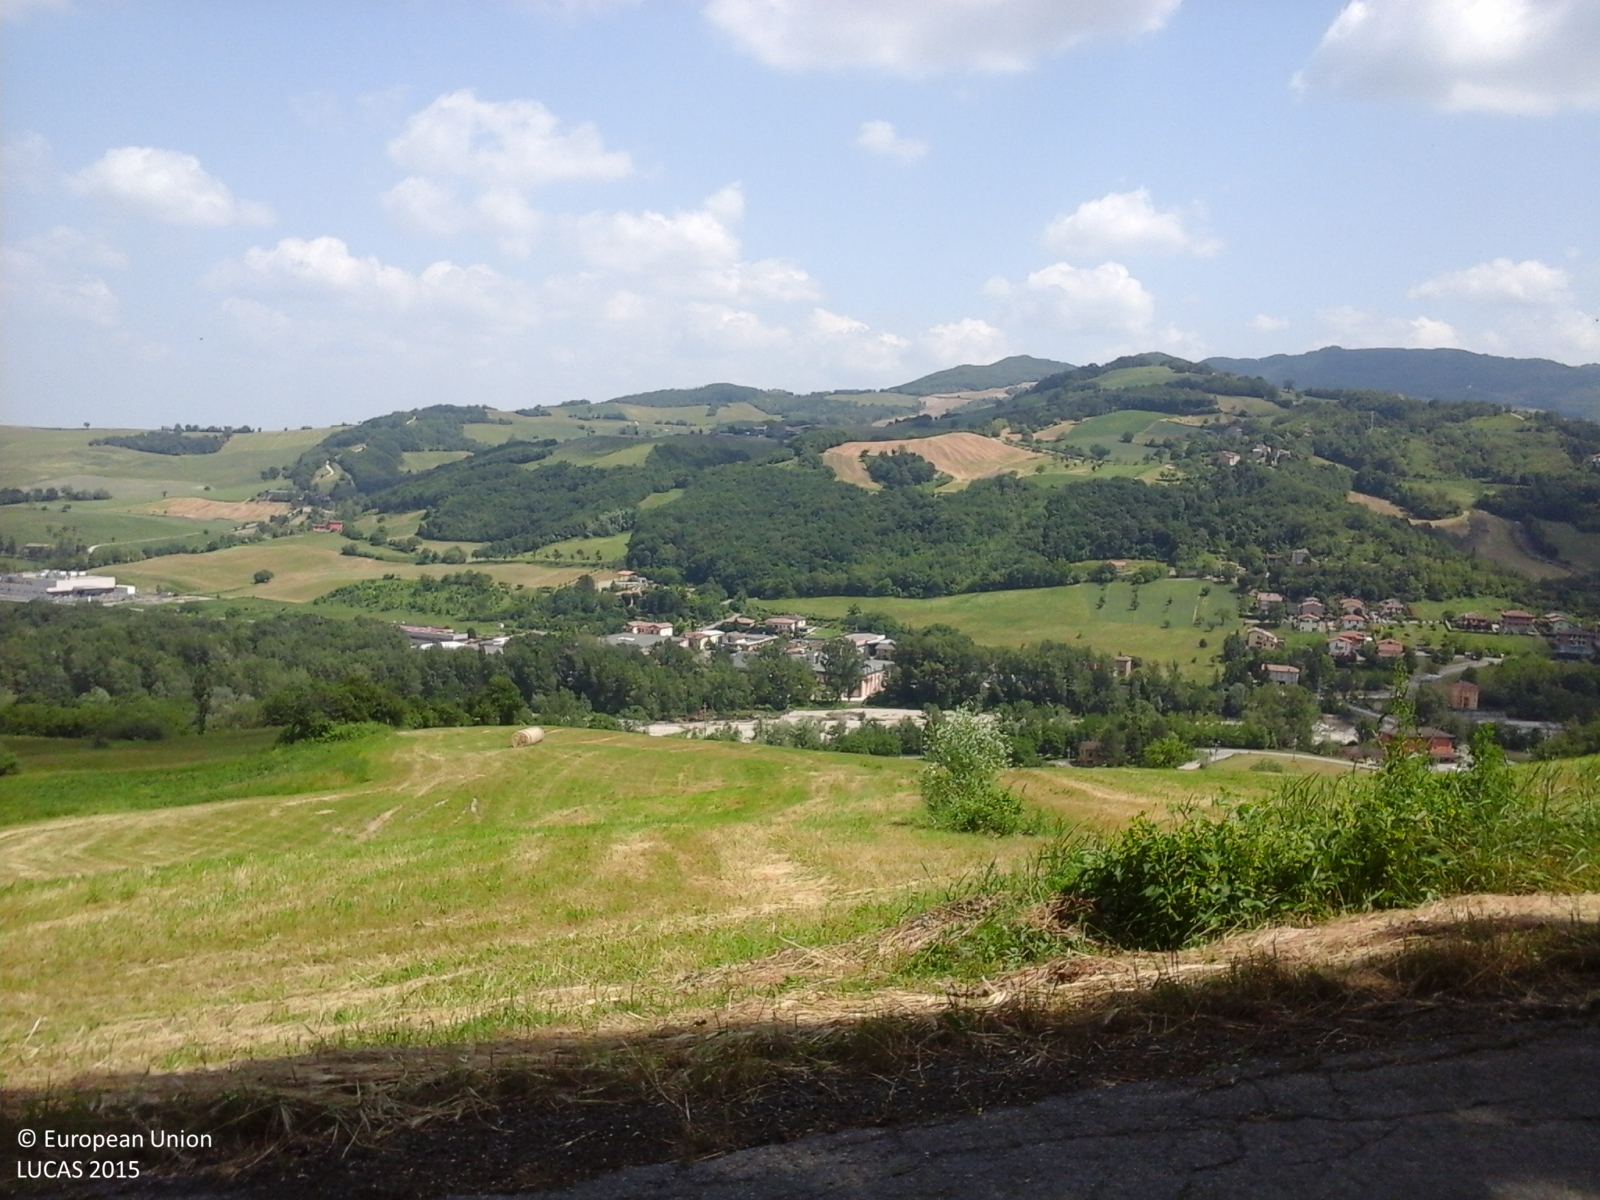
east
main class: Grassland
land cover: Grassland with sparse tree/shrub cover
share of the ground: > 75 %
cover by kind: herbaceous plants 95 %, broadleaved forest trees 5 %
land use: Residential
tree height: > 5 m
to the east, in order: Grassland with sparse tree/shrub cover; Paved roads, cycling and walking lanes; Broadleaved woodland; Artificial constructions in urban areas; Broadleaved woodland; Fences; Paved roads, cycling and walking lanes; Grass margins; Grassland without tree/shrub cover; Lucerne; Spontaneously vegetated surfaces; Ditches and canals; Lucerne
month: May
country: IT
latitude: 44.6390
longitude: 10.1635
